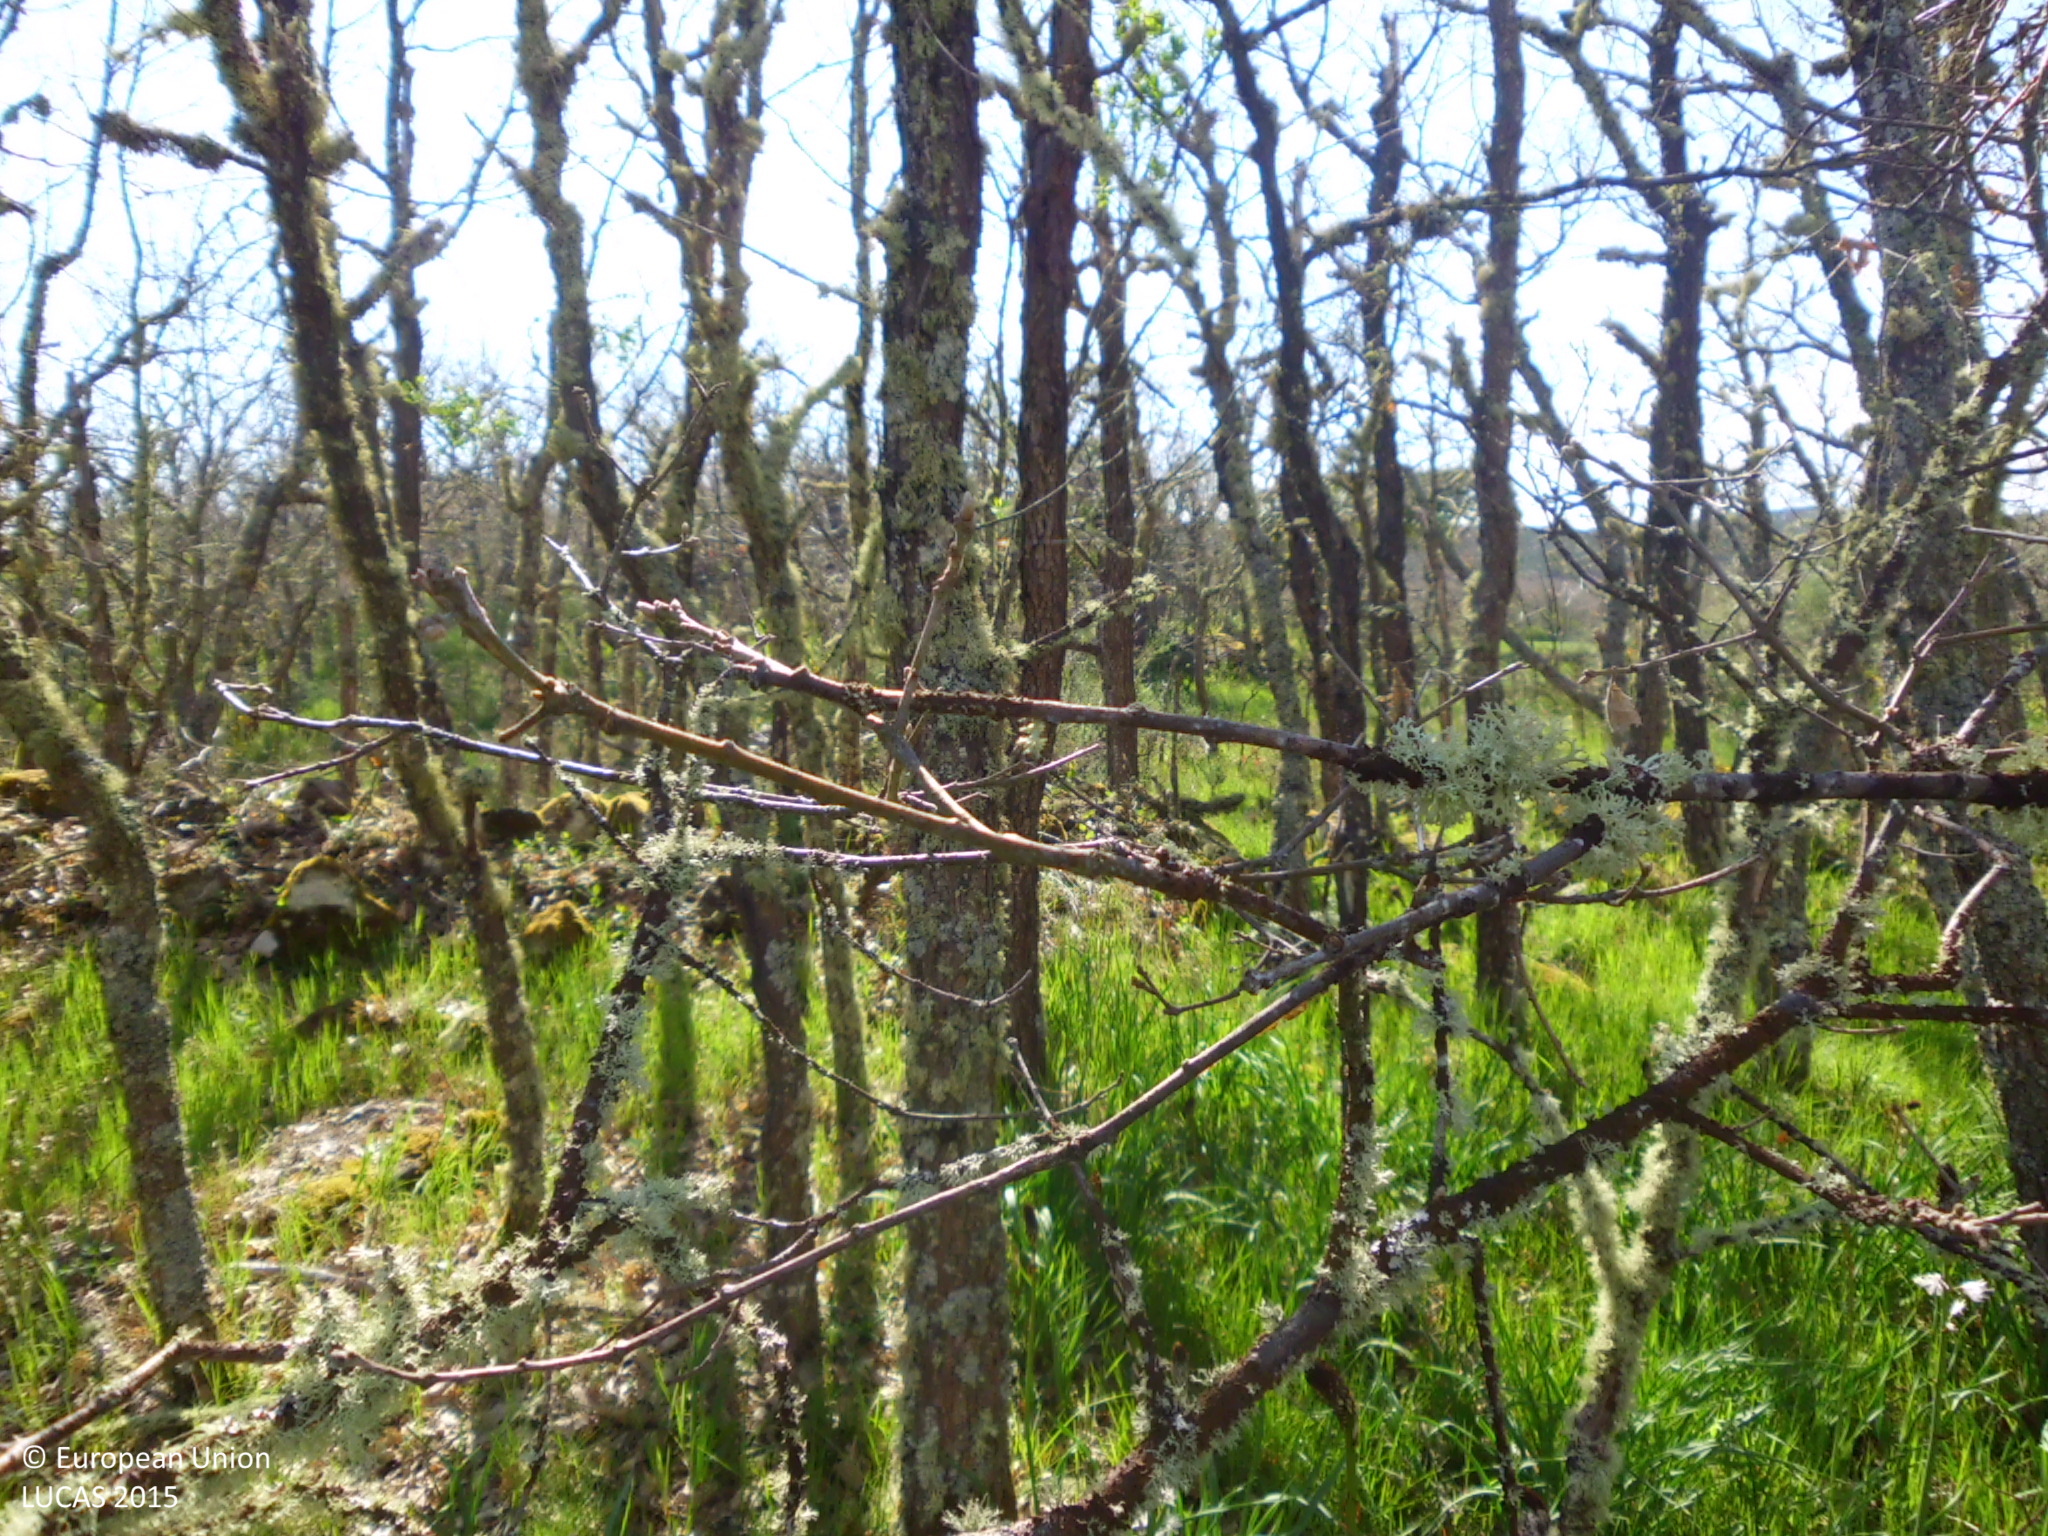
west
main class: Woodland
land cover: Broadleaved woodland
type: acidophilous oak and oak-birch forest
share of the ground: > 75 %
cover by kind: broadleaved forest trees 85 %, shrubs 10 %, herbaceous plants 5 %
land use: Semi-natural and natural areas not in use
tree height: < 5 m
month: May
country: ES
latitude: 42.8185
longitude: -4.0759
